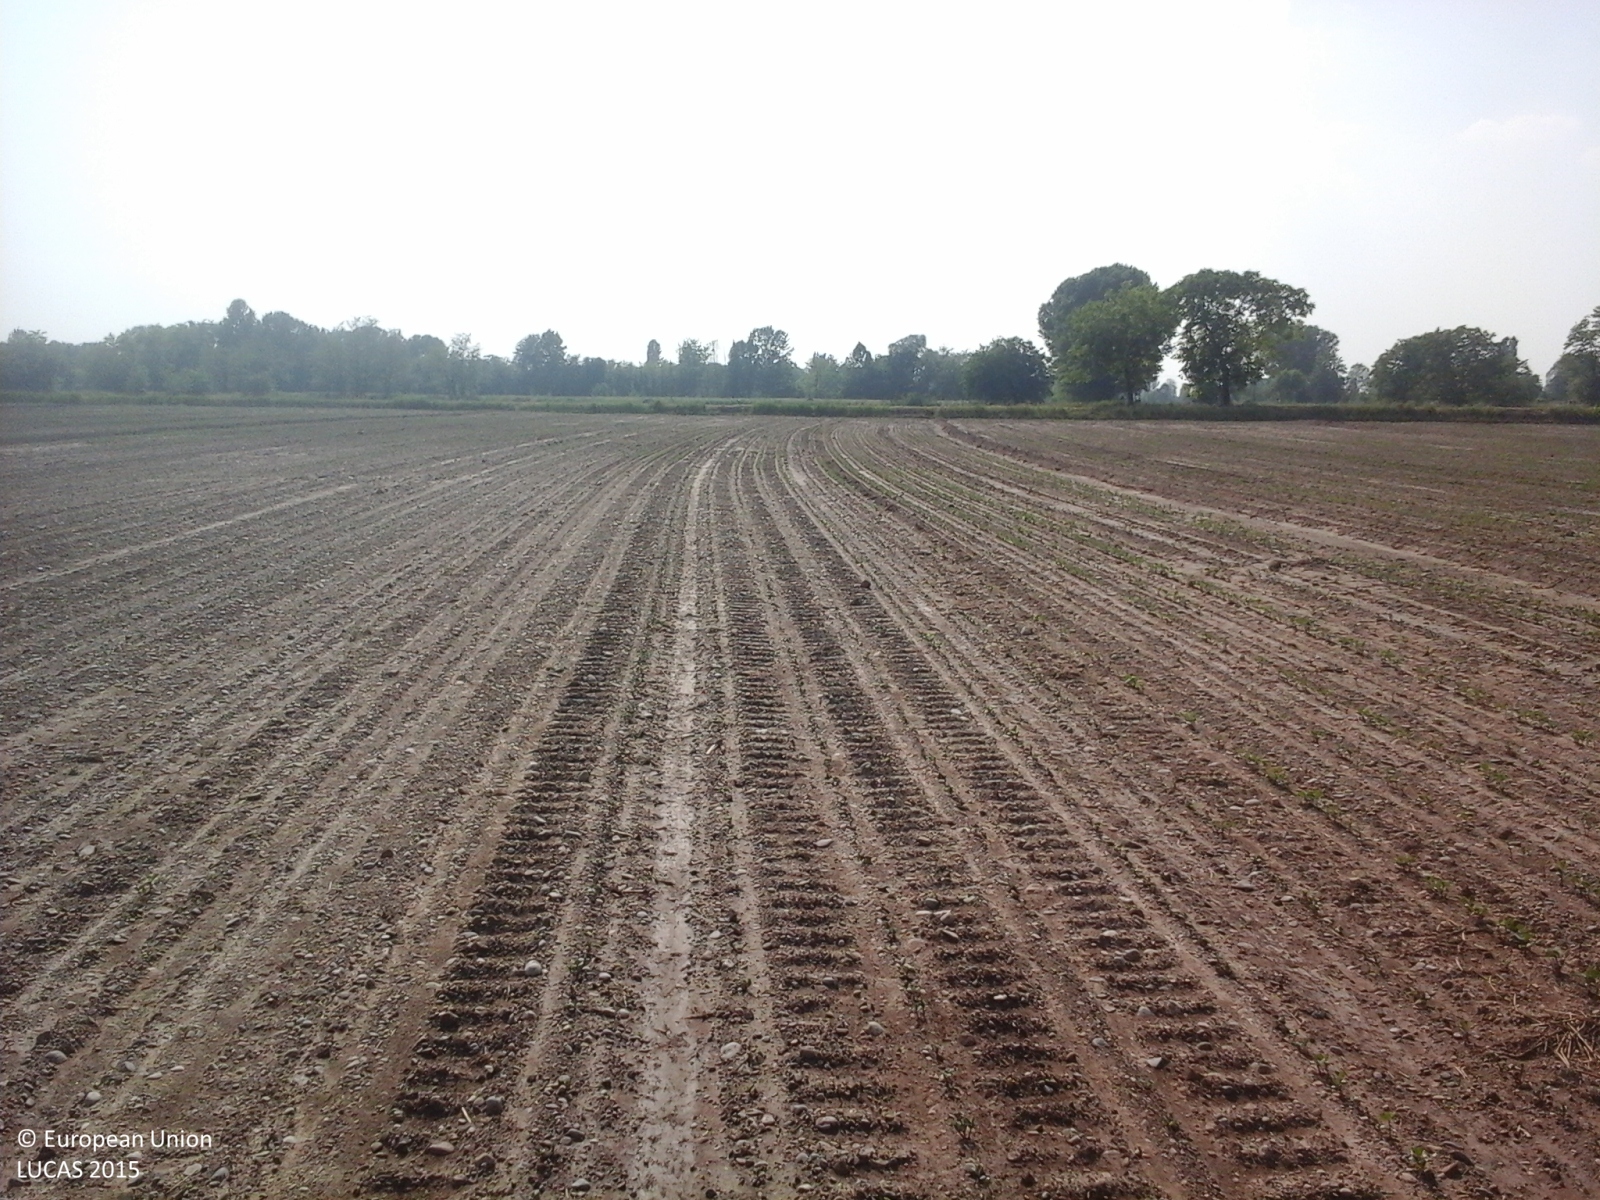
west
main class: Cropland
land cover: Soya
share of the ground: < 10 %
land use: Agriculture (excluding fallow land and kitchen gardens)
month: May
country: IT
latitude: 45.2874
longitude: 10.3945
